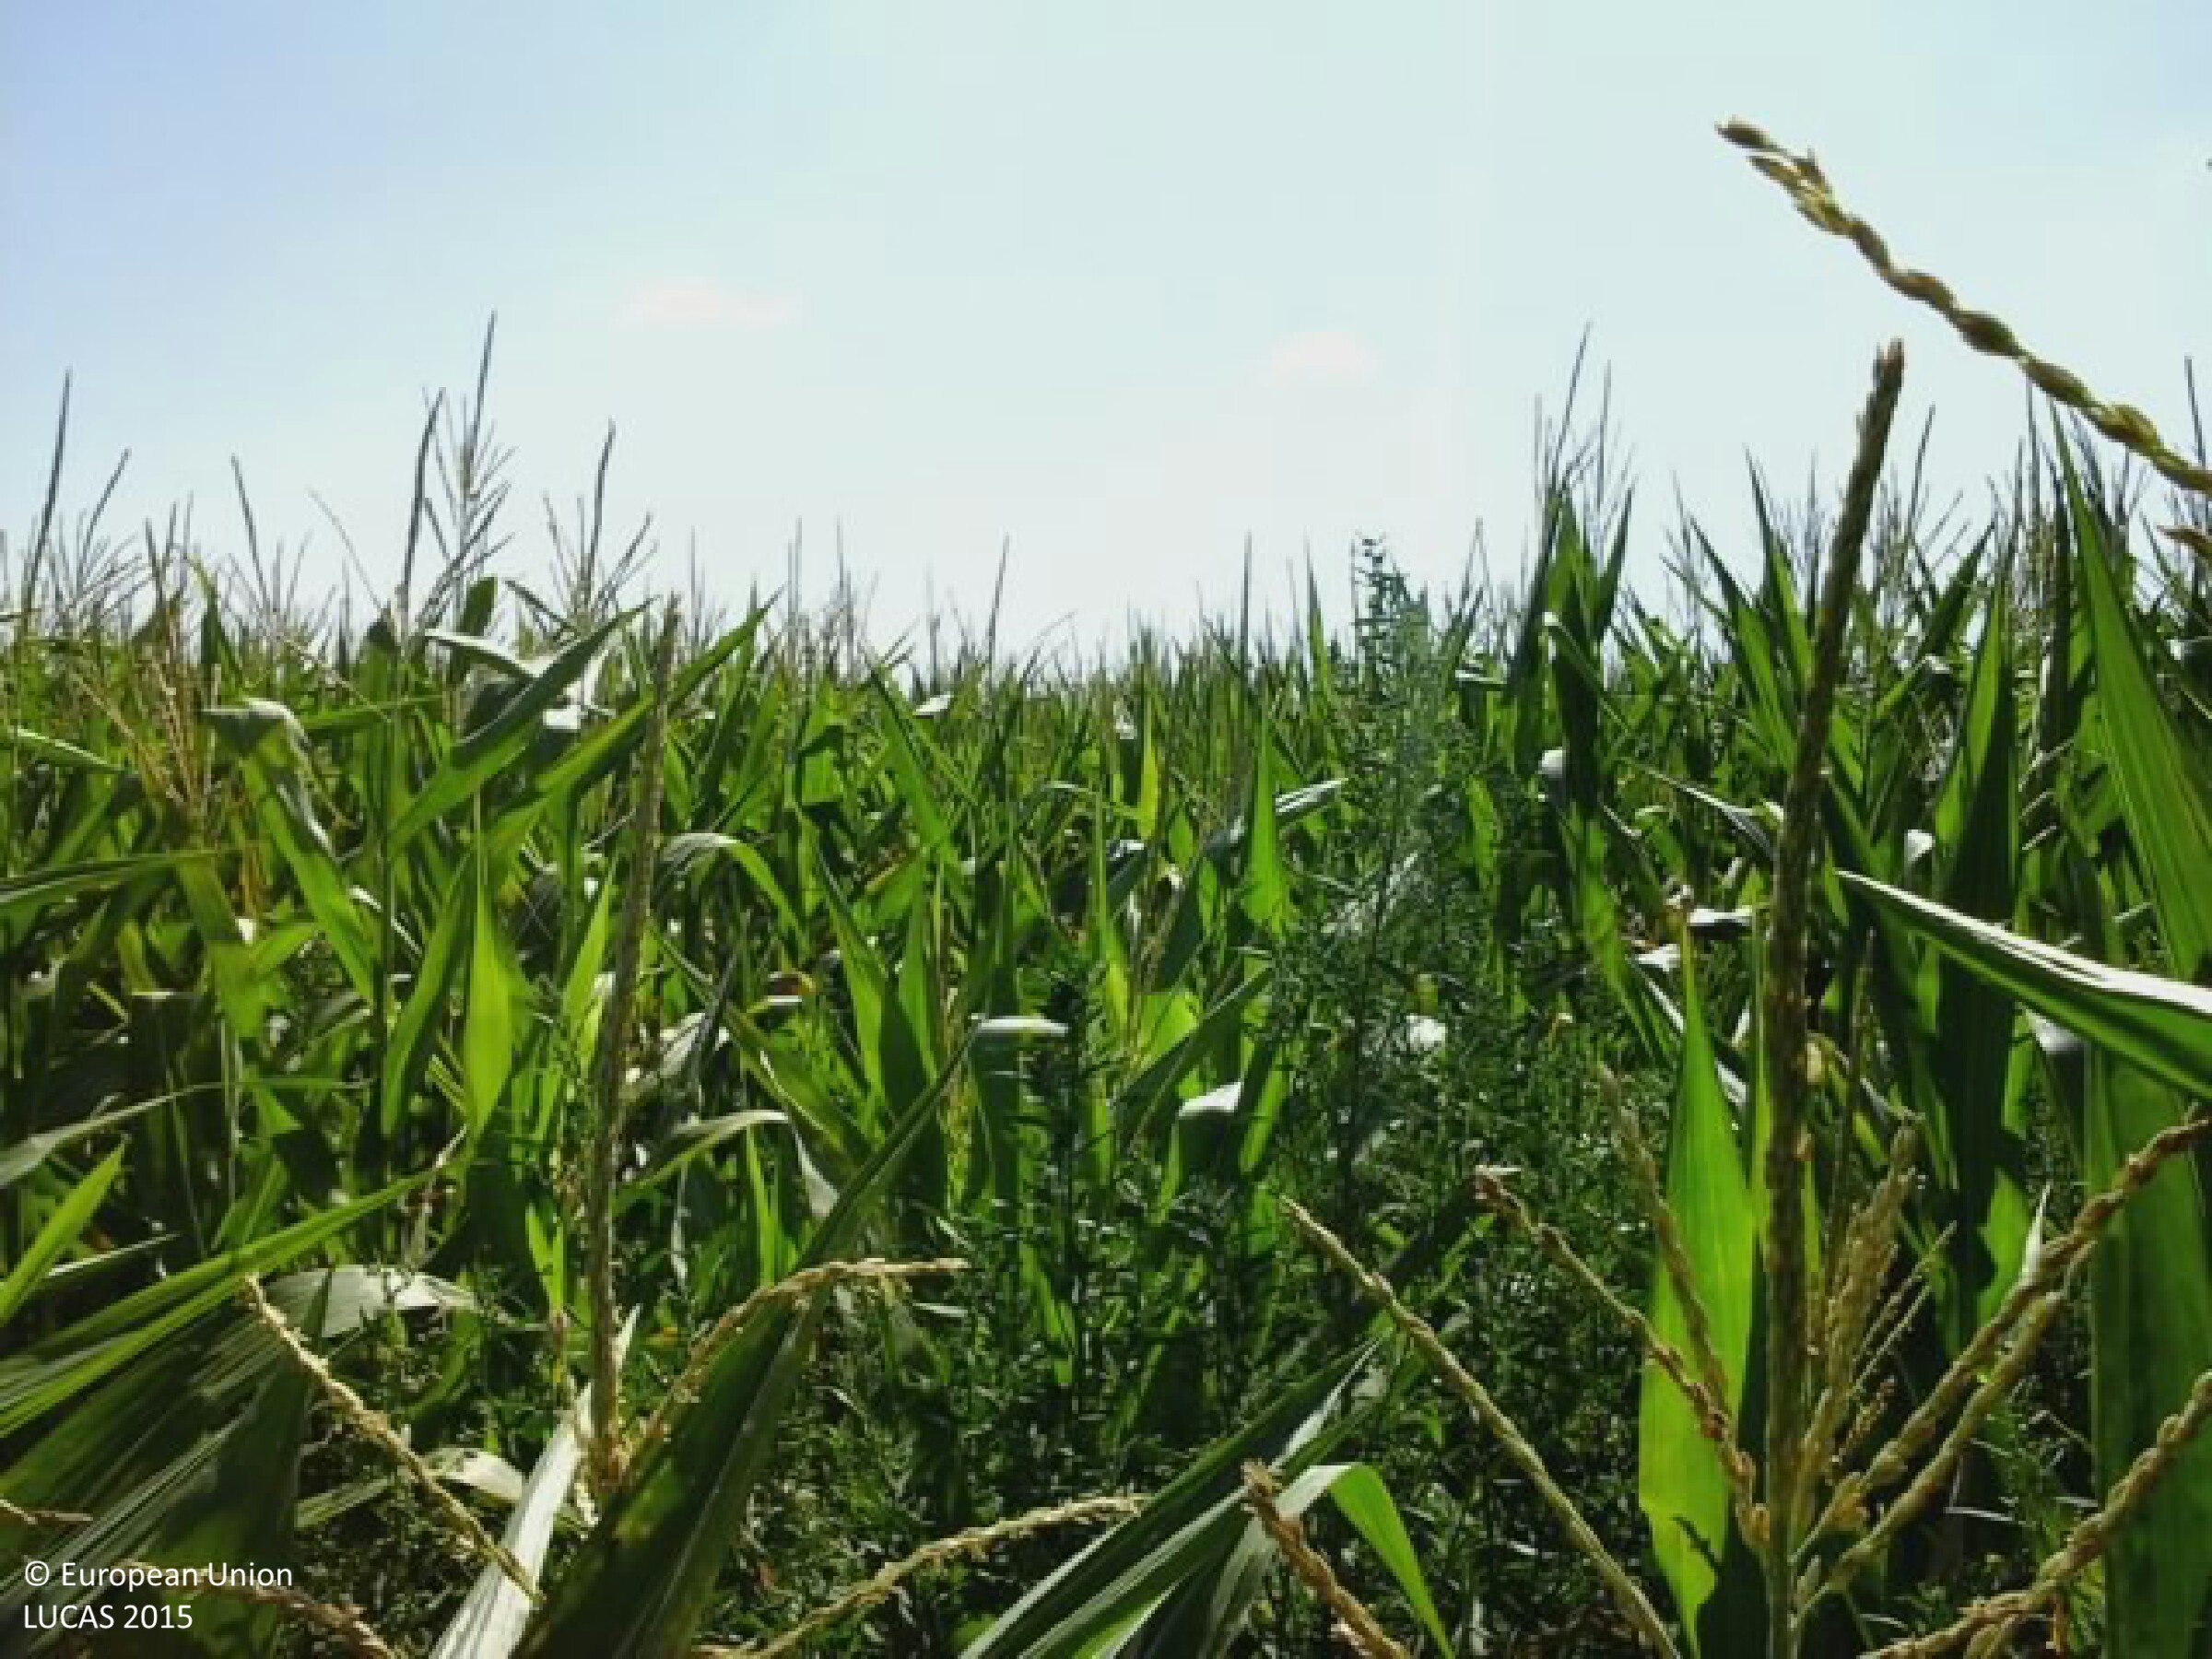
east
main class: Cropland
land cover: Potatoes
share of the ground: 50 - 75 %
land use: Agriculture (excluding fallow land and kitchen gardens)
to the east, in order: Potatoes; Maize; Grassland without tree/shrub cover; Tracks; Grass margins; Tracks; Grass margins; Potatoes; Tracks; Potatoes; Other fresh vegetables; Other bare soil; Potatoes; Common wheat
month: July
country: HU
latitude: 47.3141
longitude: 19.1857
